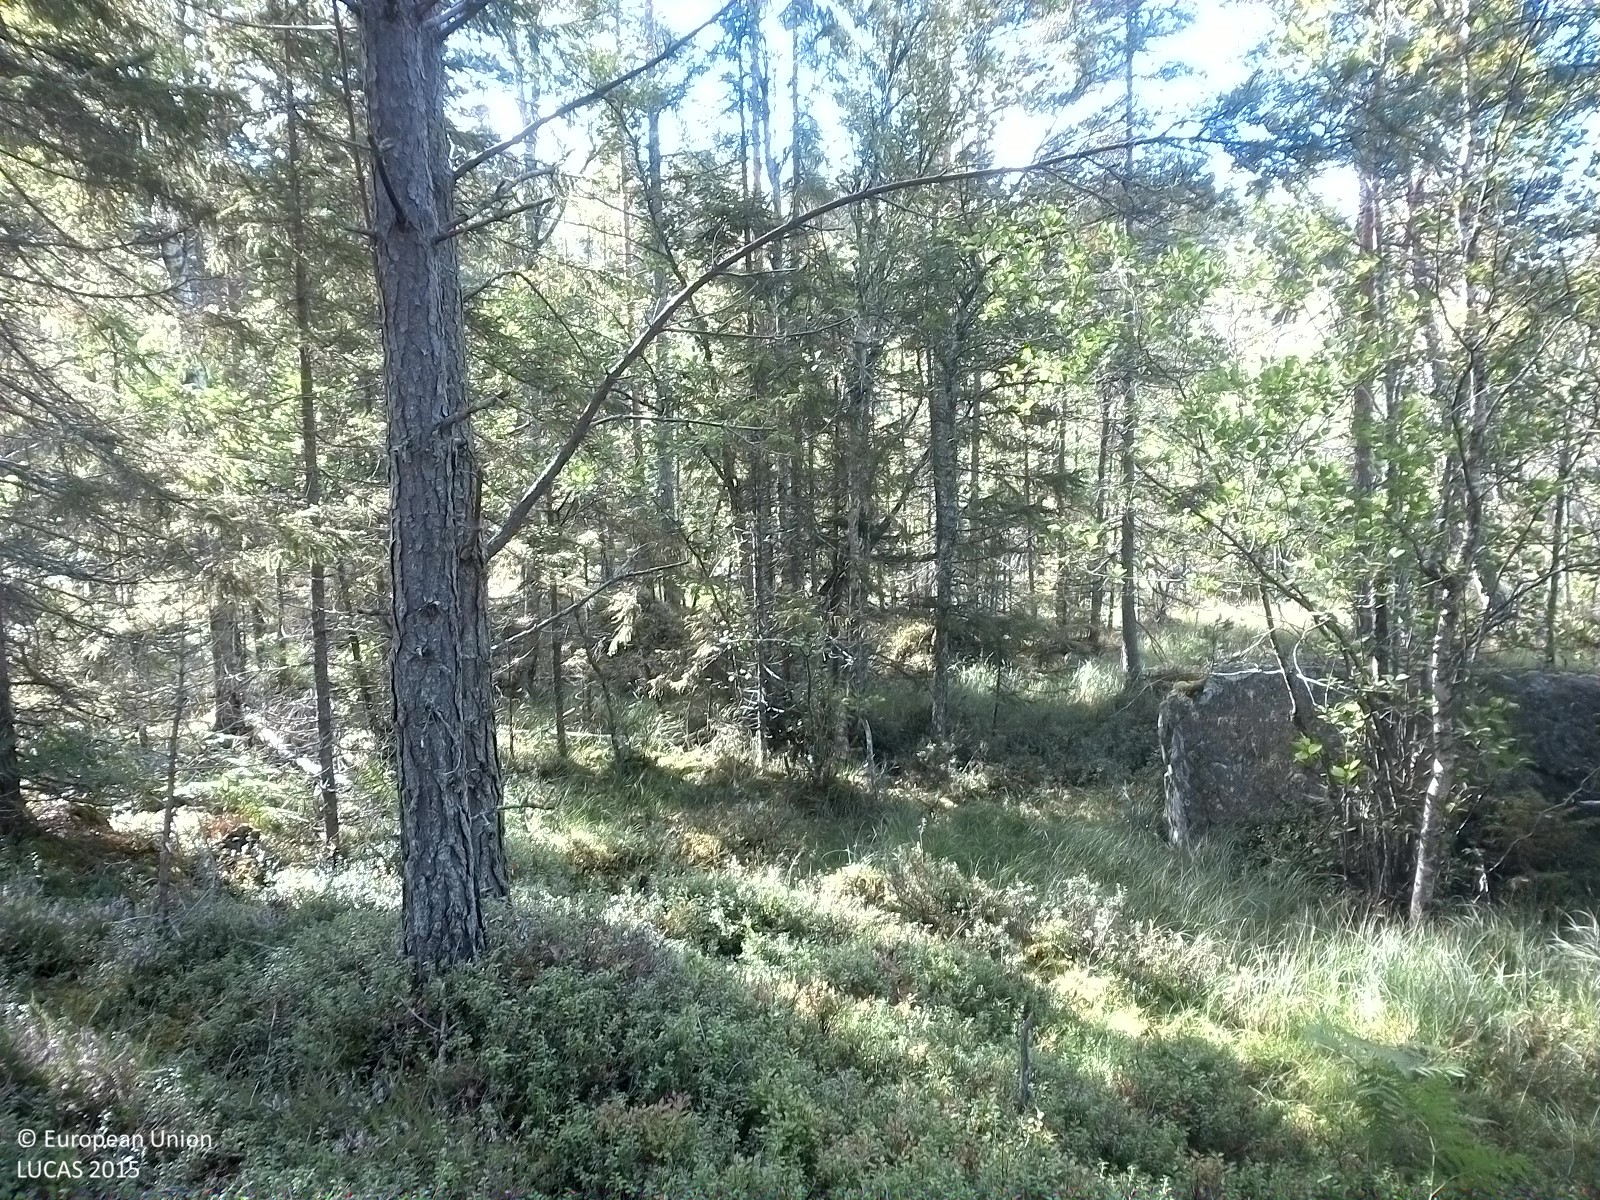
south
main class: Woodland
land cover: Pine dominated coniferous woodland
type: boreal forest
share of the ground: 25 - 50 %
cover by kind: herbaceous plants 45 %, coniferous forest trees 30 %, shrubs 15 %, lichens and mosses 10 %
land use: Forestry
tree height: > 5 m
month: August
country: SE
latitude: 58.9352
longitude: 15.5355
